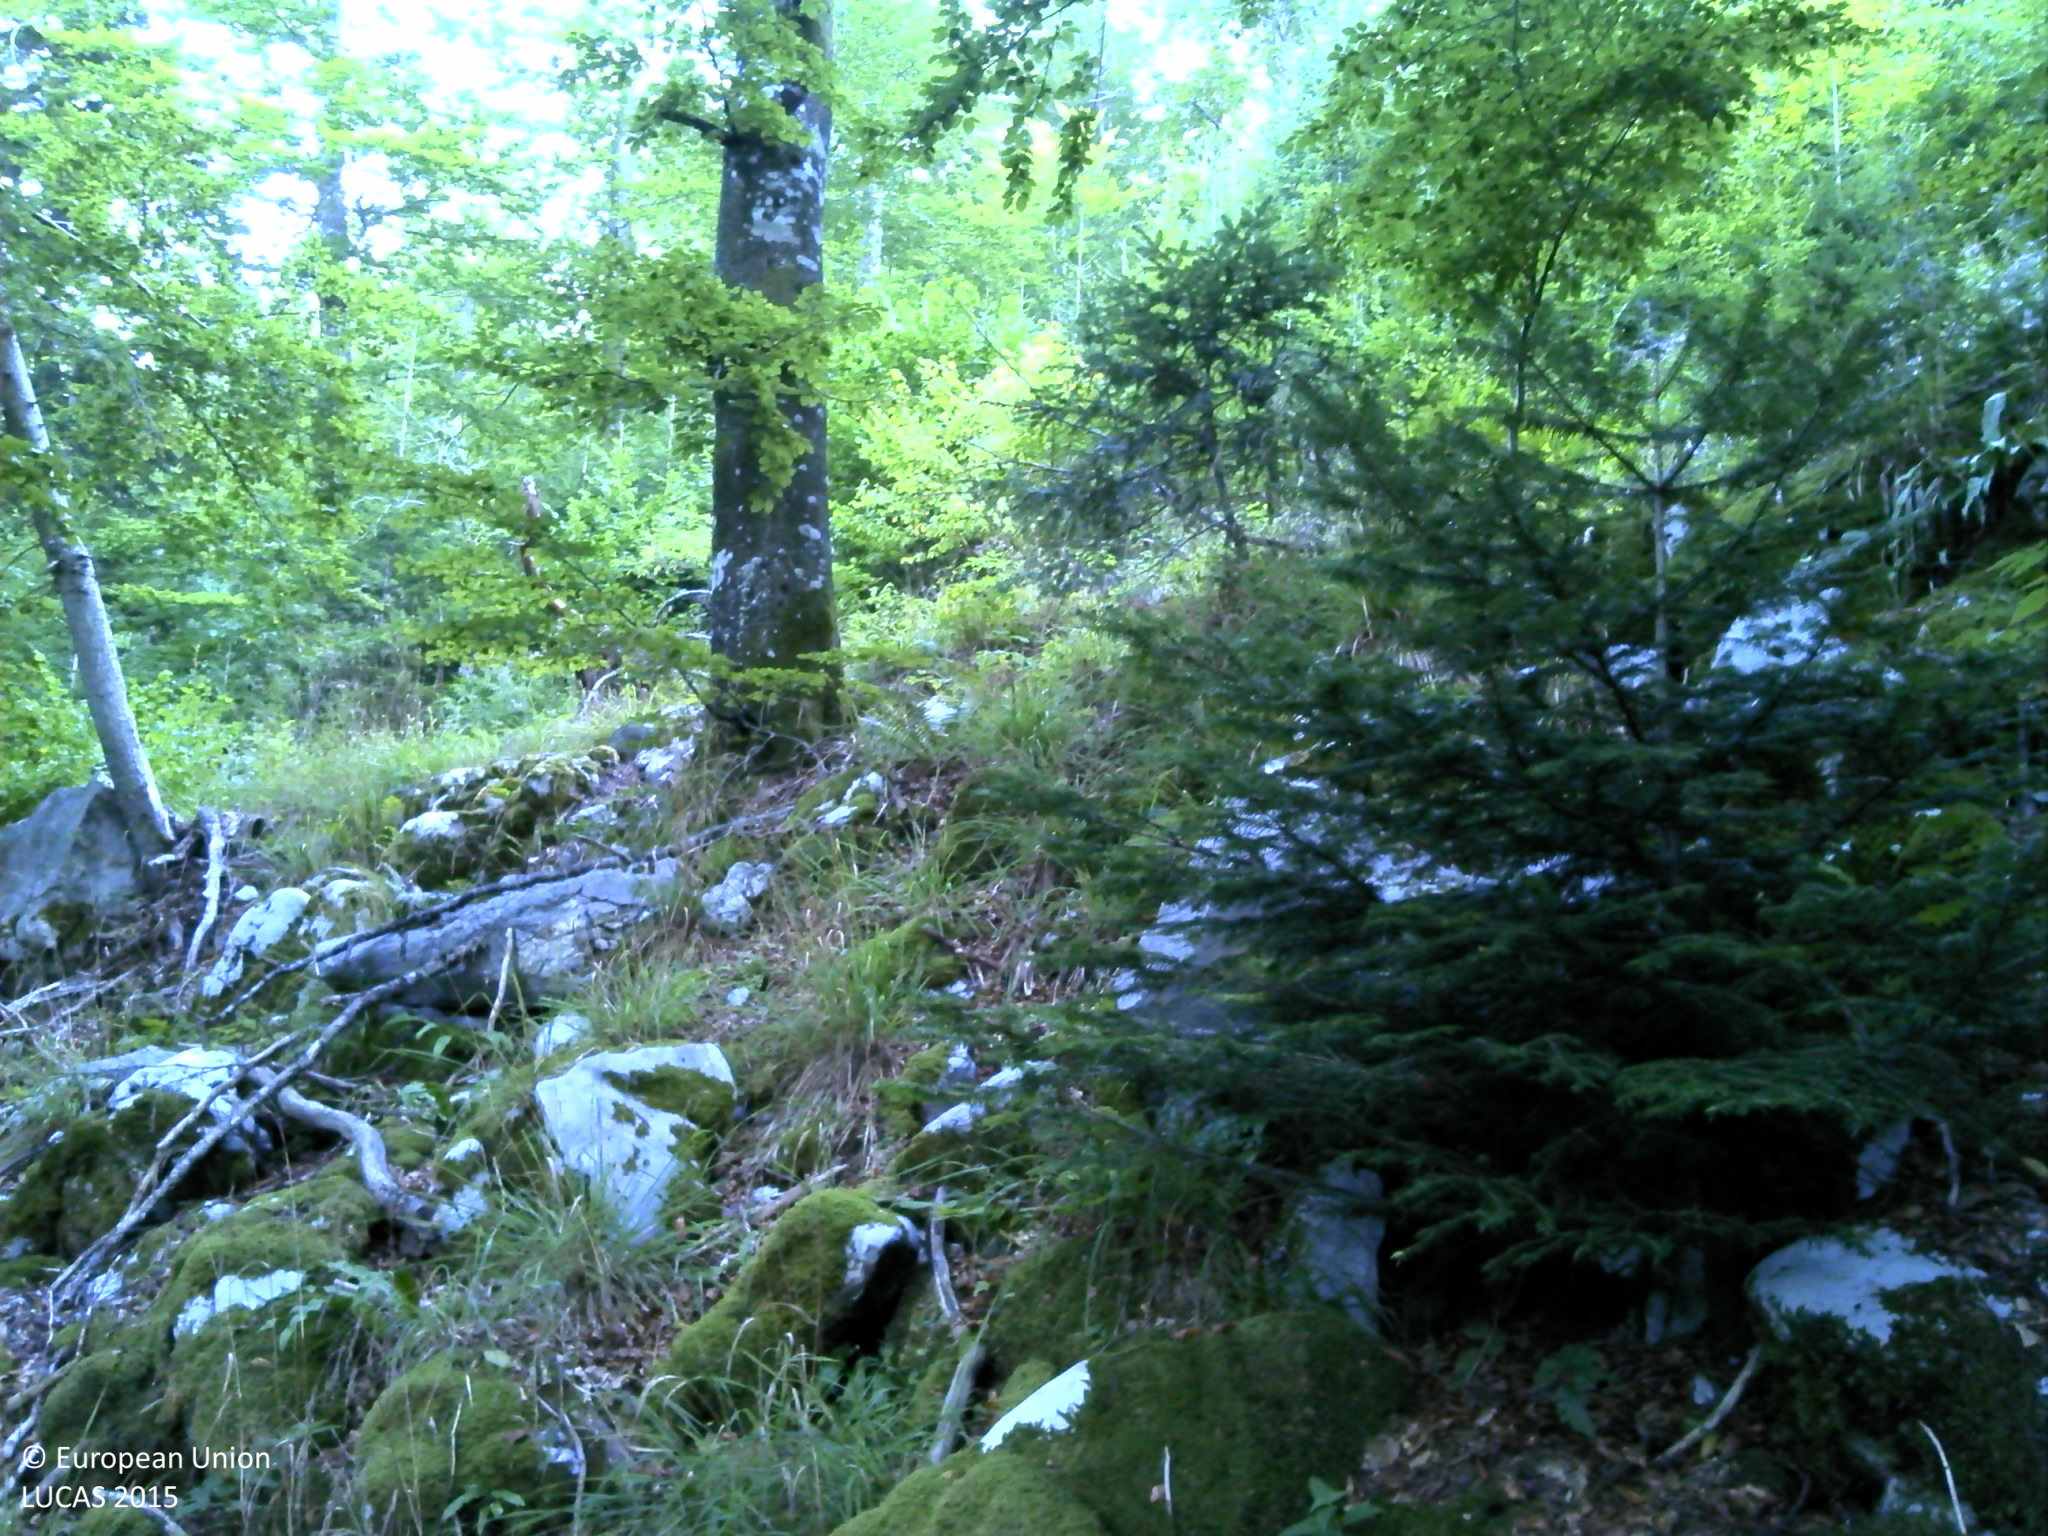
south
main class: Woodland
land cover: Other mixed woodland
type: mountainous beech forest
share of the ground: > 75 %
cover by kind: broadleaved forest trees 60 %, coniferous forest trees 30 %, herbaceous plants 5 %, unconsolidated bare surface 5 %
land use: Forestry
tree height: > 5 m
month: August
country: HR
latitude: 45.0952
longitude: 15.0393
